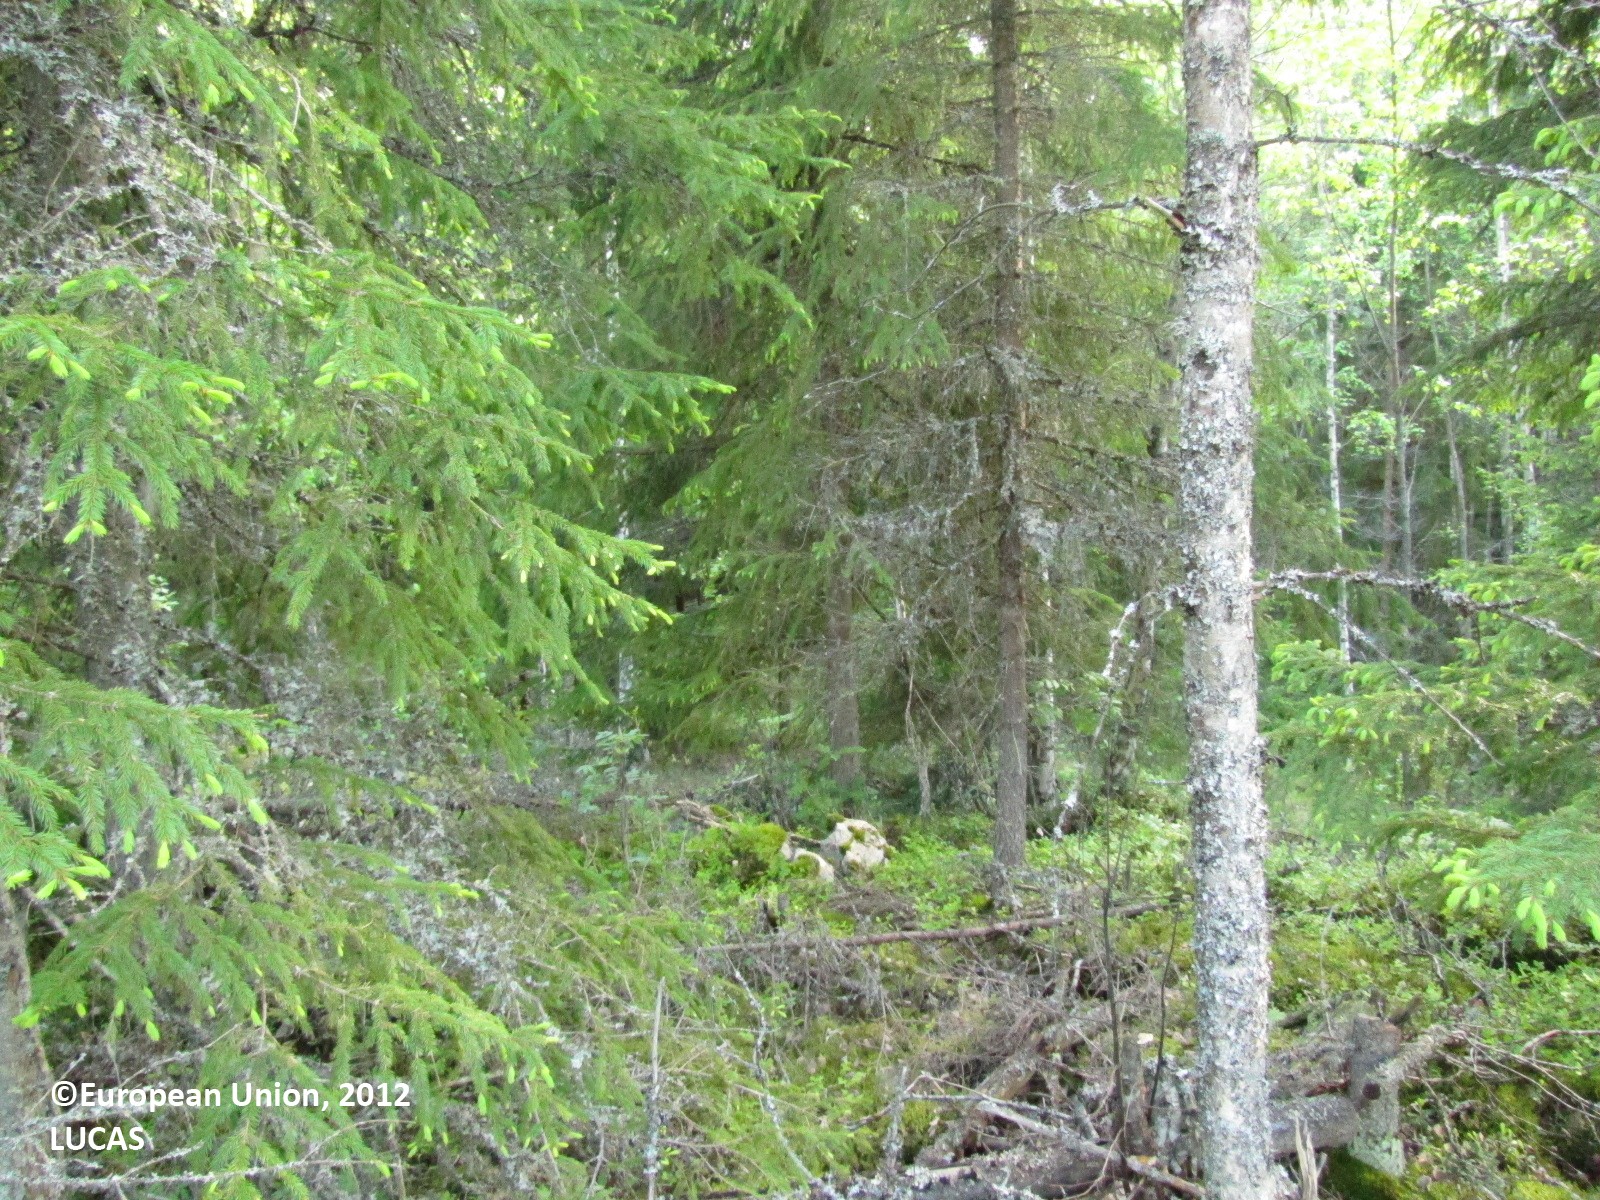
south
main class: Woodland
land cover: Spruce dominated coniferous woodland
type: boreal forest
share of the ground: > 75 %
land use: Forestry
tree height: < 5 m
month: June
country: FI
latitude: 61.6143
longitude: 22.9096
